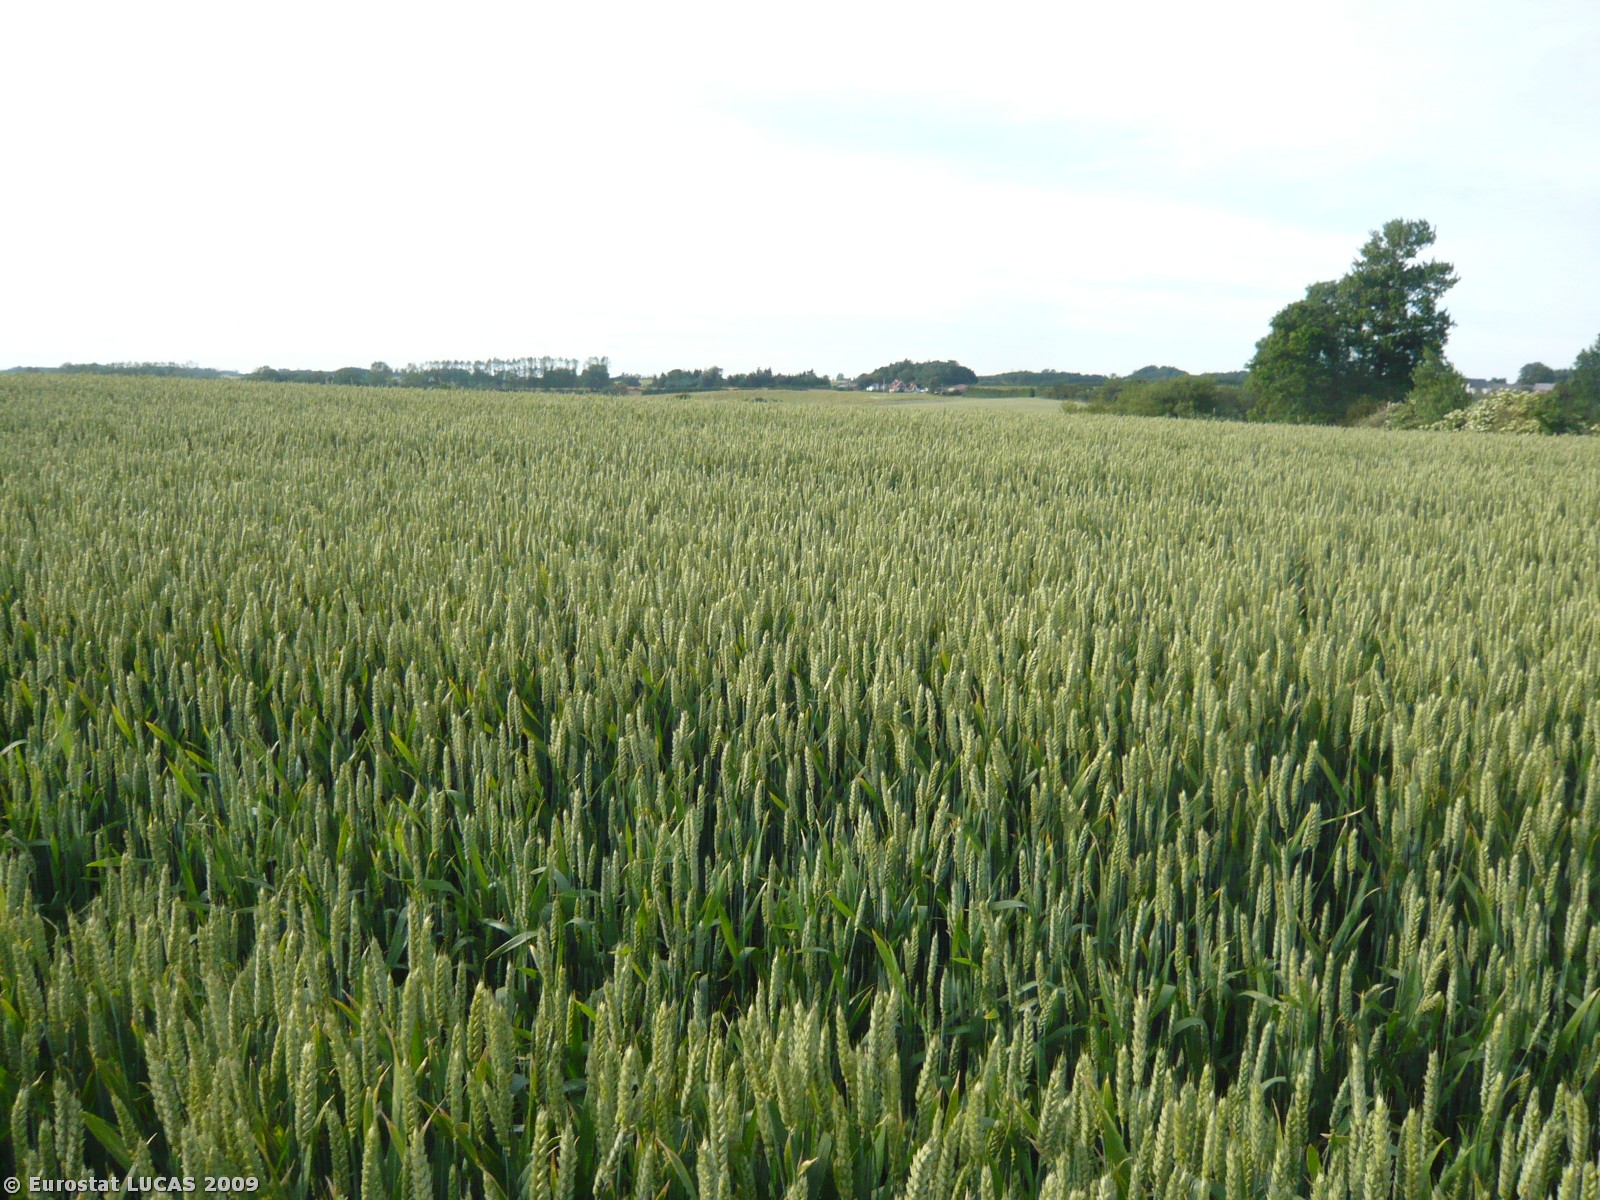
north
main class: Cropland
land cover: Common wheat
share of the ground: > 75 %
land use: Agriculture (excluding fallow land and kitchen gardens)
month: June
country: DK
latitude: 55.1630
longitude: 10.2039
